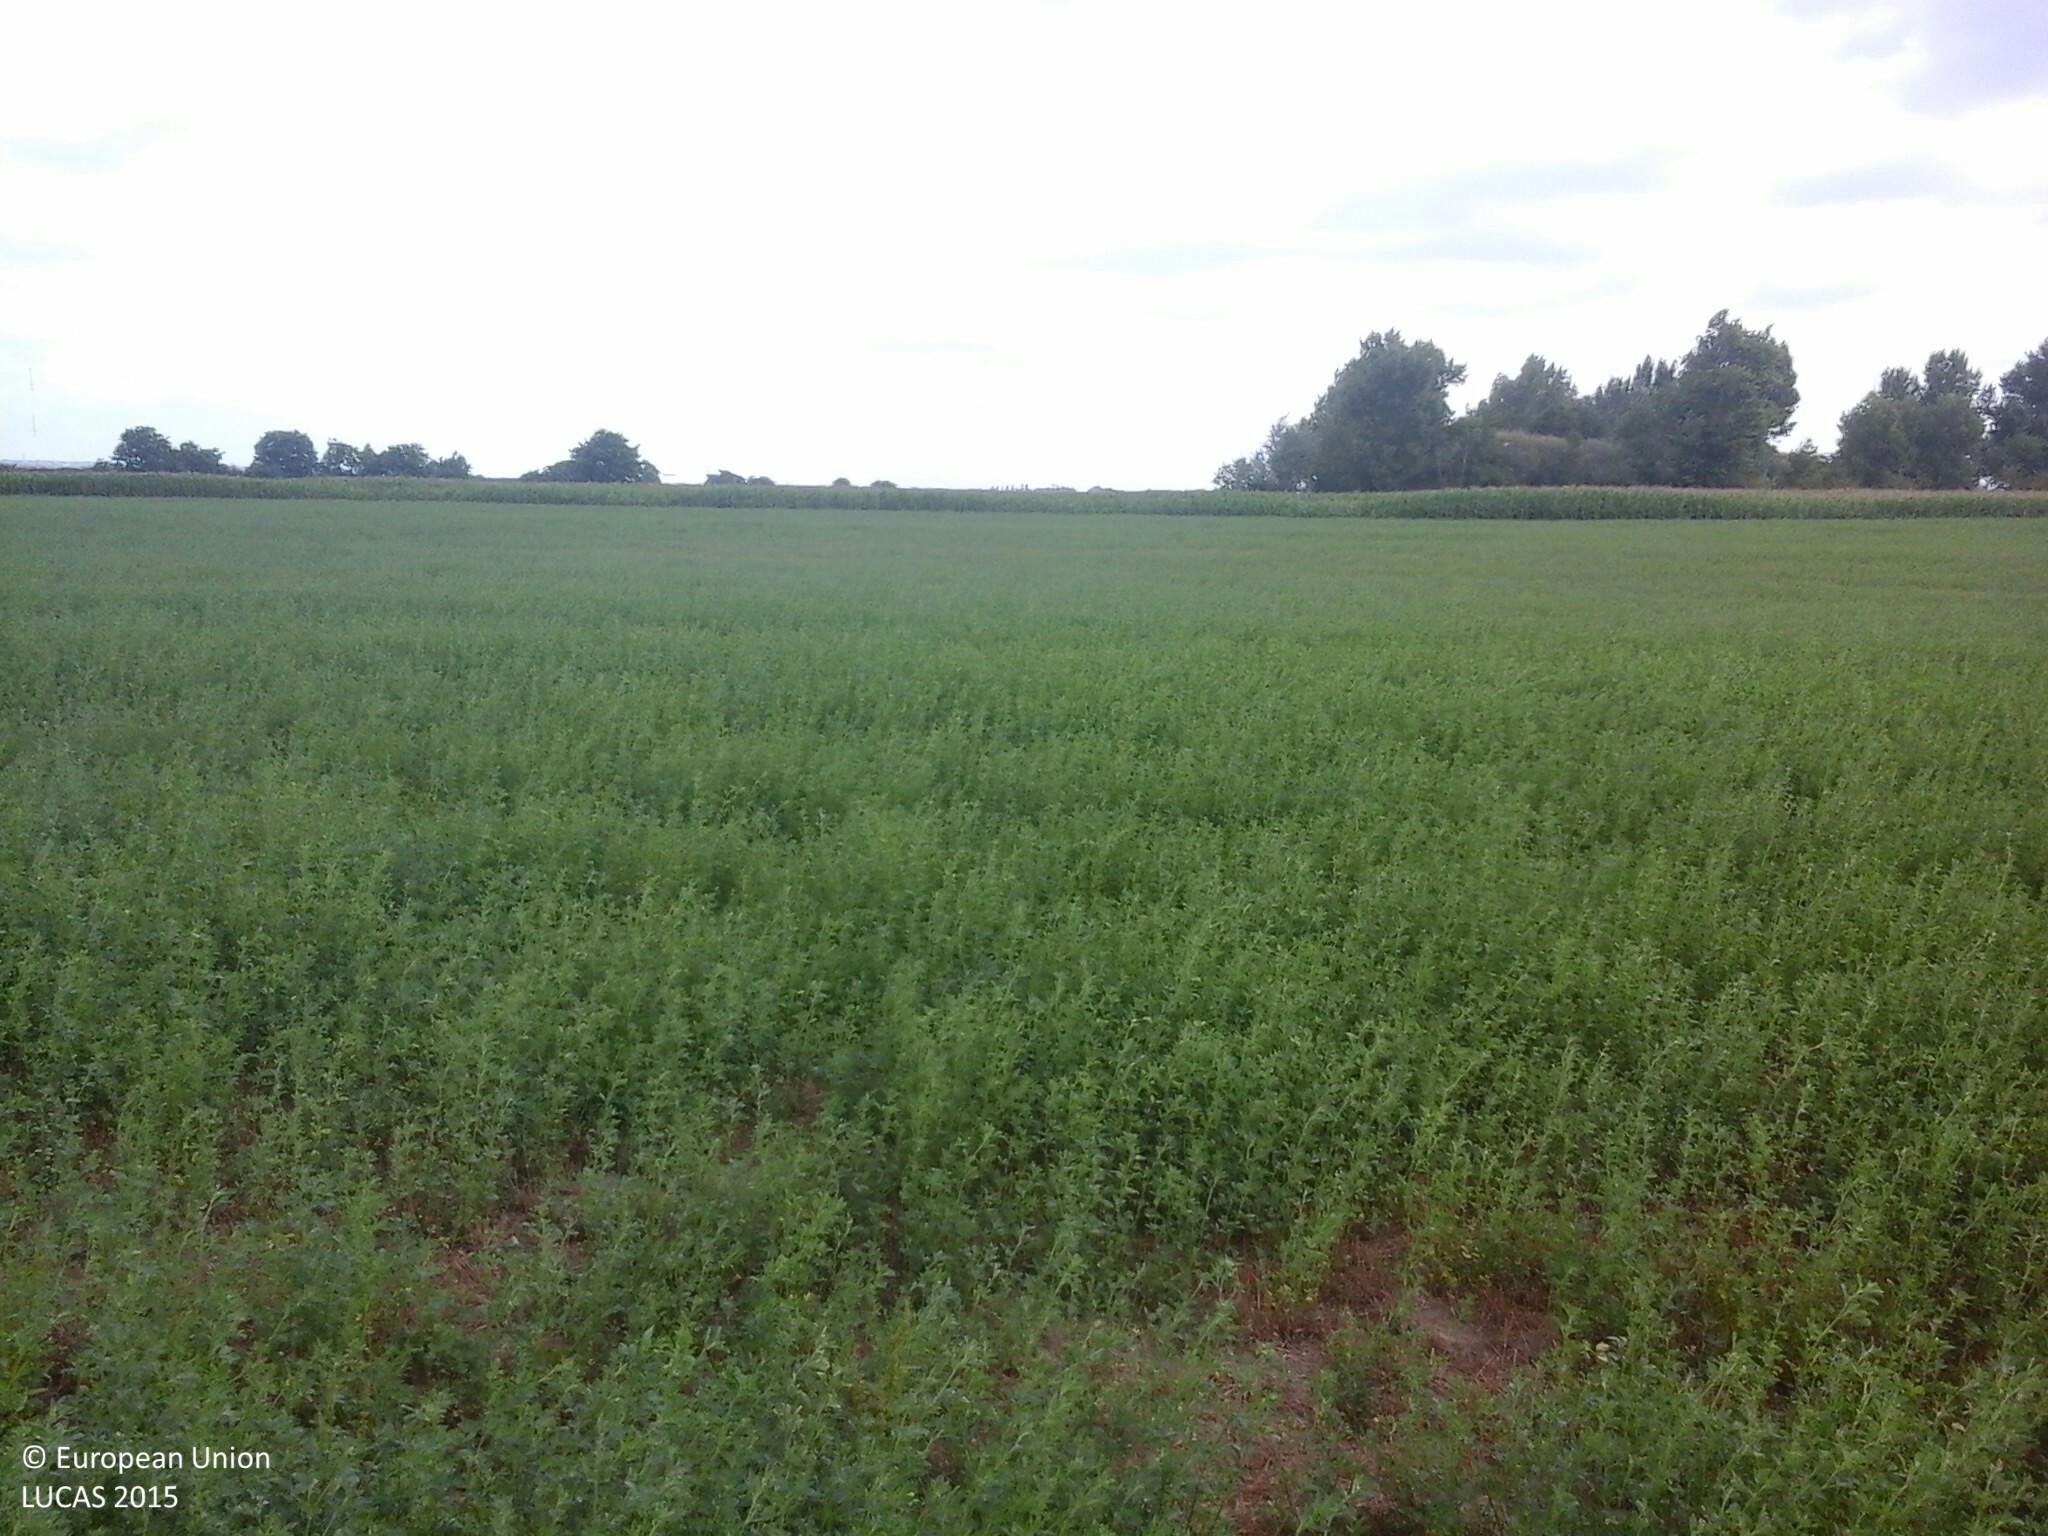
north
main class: Cropland
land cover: Lucerne
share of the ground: > 75 %
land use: Agriculture (excluding fallow land and kitchen gardens)
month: July
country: HU
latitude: 47.3474
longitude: 19.0048
